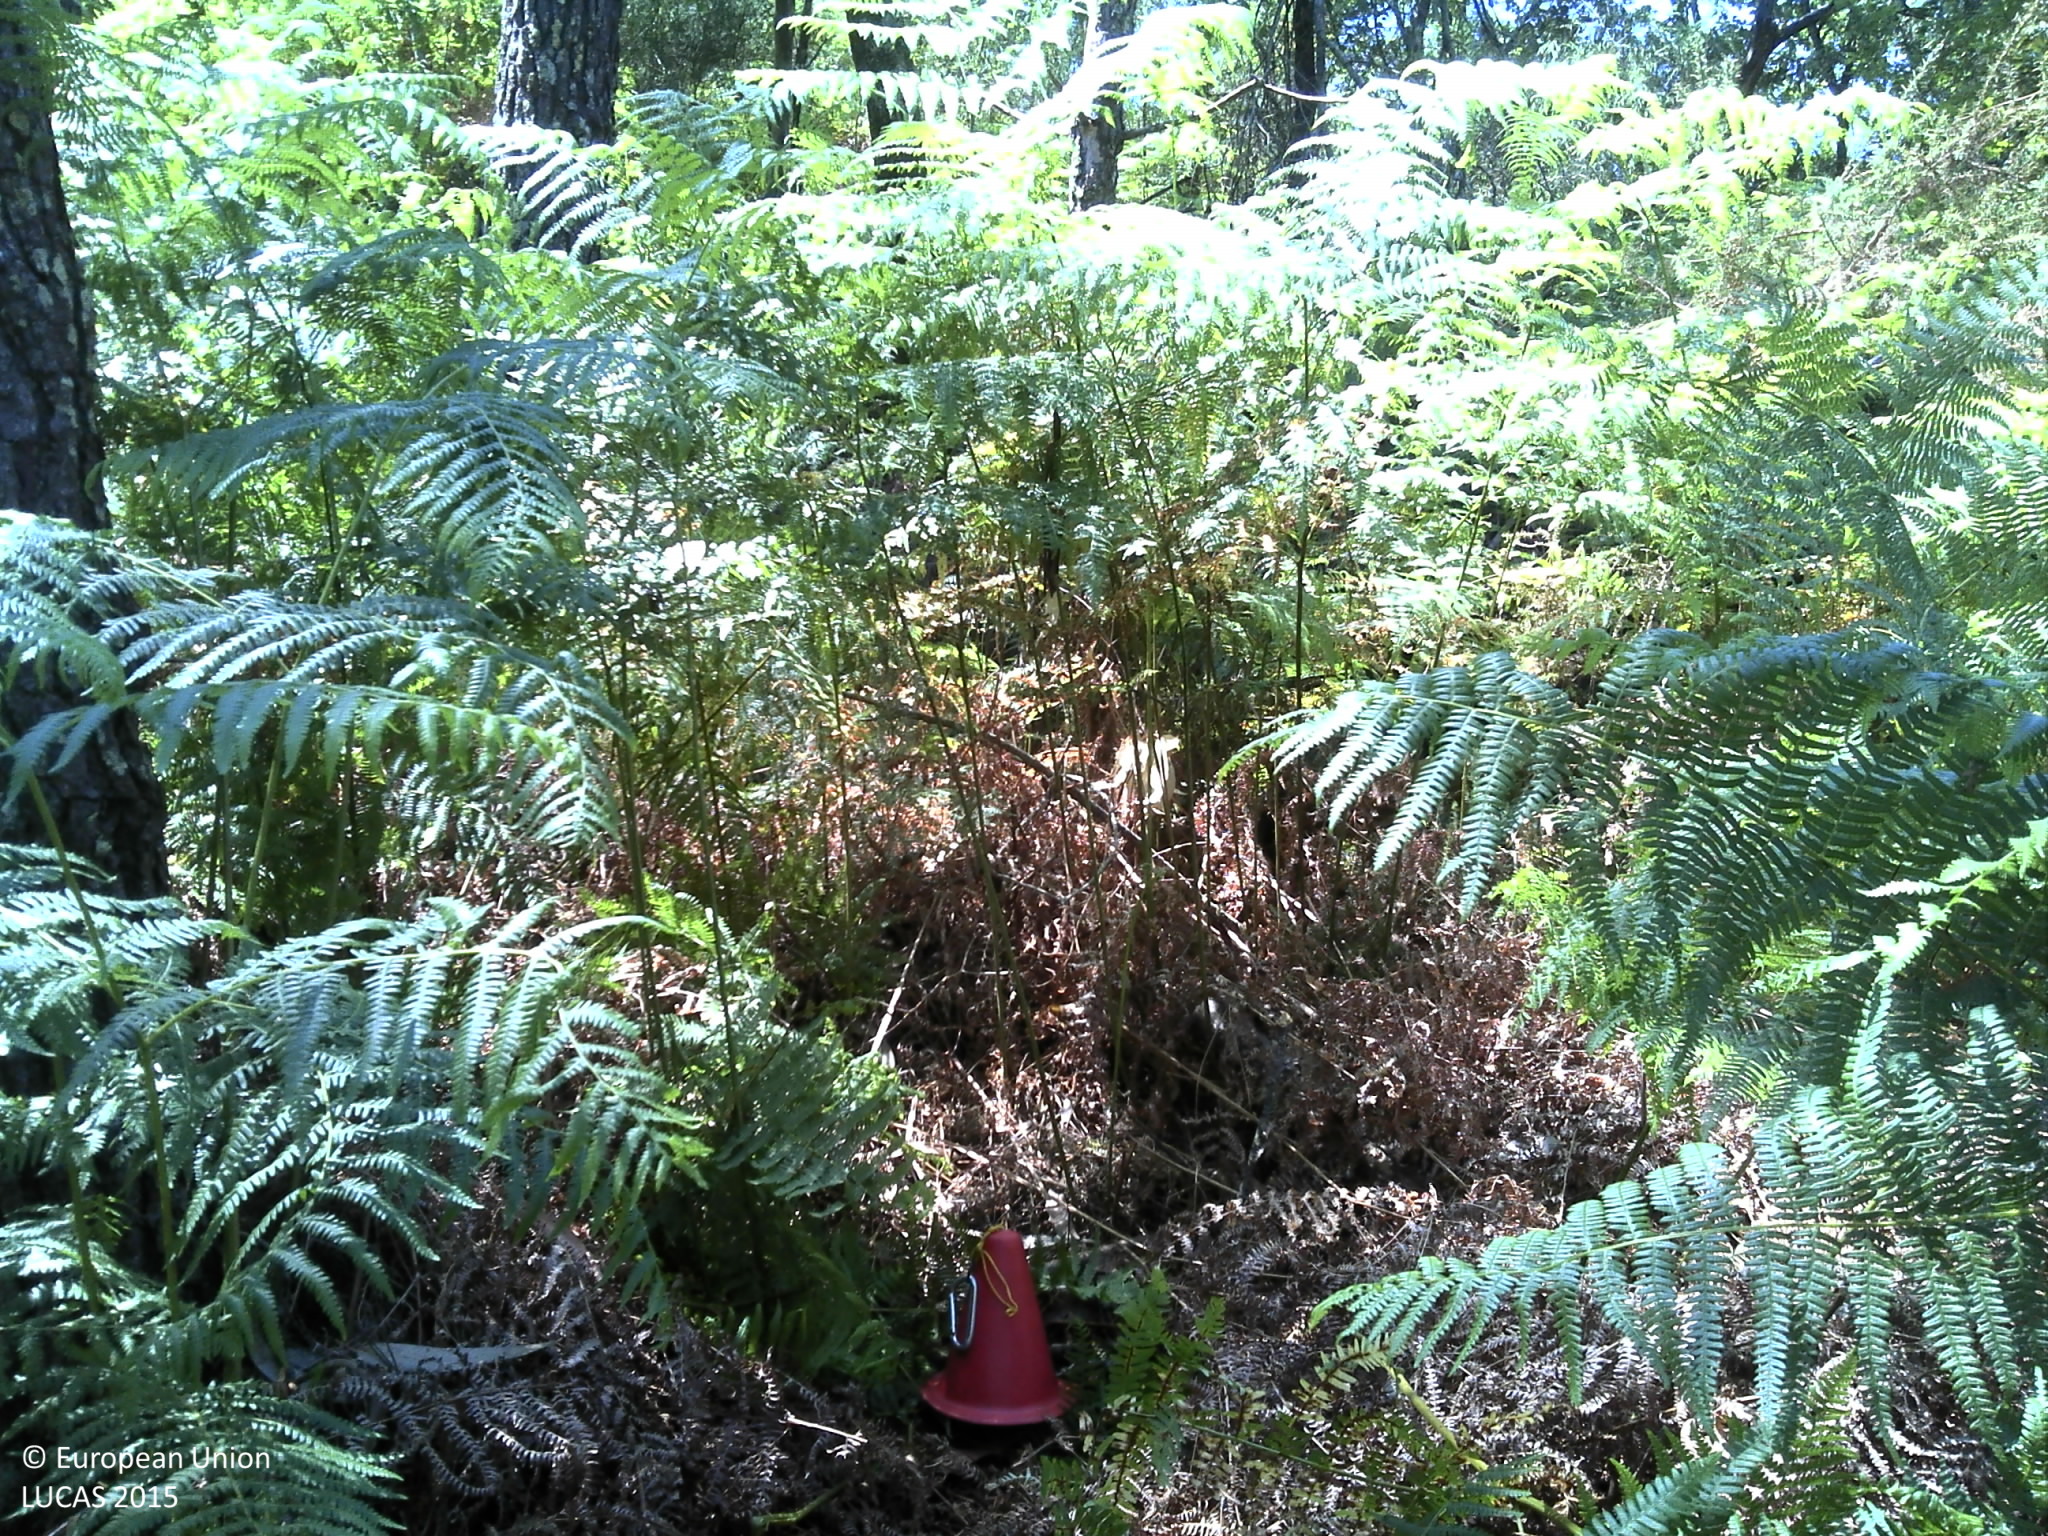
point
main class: Woodland
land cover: Pine dominated mixed woodland
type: coniferous forest of the mediterranean region
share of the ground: 50 - 75 %
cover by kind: coniferous forest trees 75 %, broadleaved forest trees 25 %
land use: Forestry
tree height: > 5 m
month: June
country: PT
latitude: 41.9380
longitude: -8.4578
